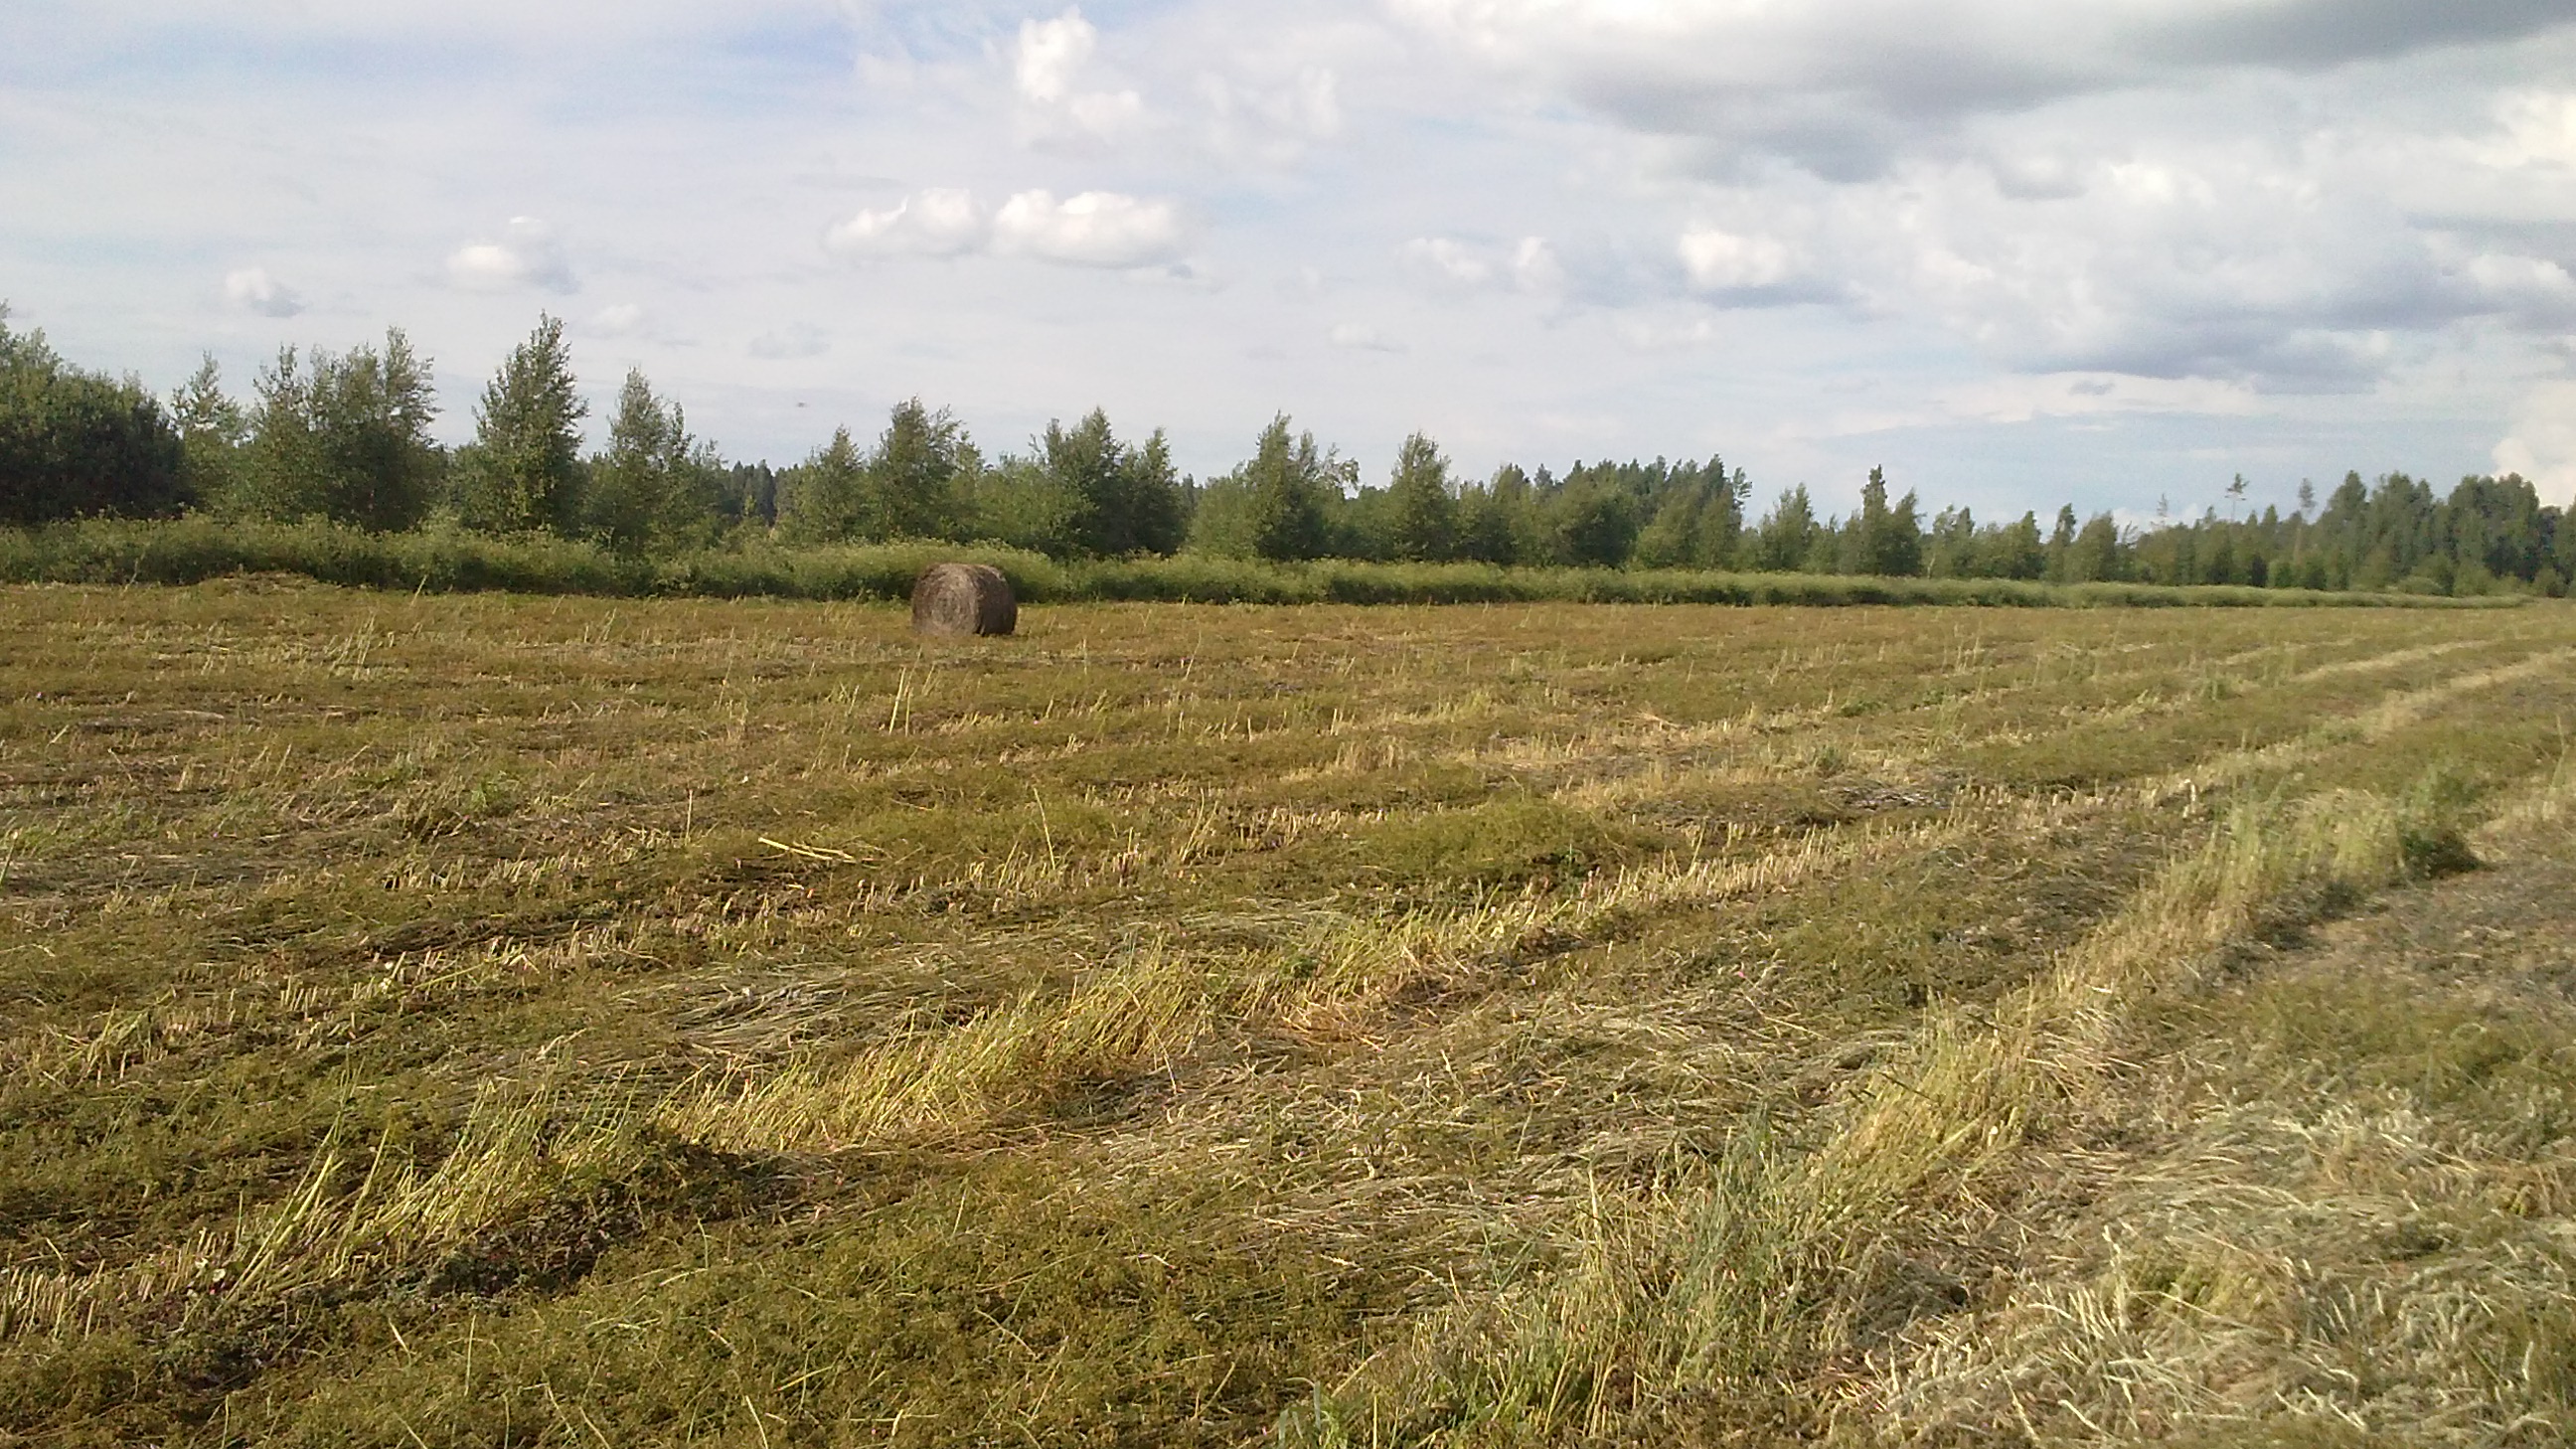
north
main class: Grassland
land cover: Grassland without tree/shrub cover
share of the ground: > 75 %
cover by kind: herbaceous plants 100 %
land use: Agriculture (excluding fallow land and kitchen gardens)
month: June
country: LV
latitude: 56.6562
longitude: 27.8571
